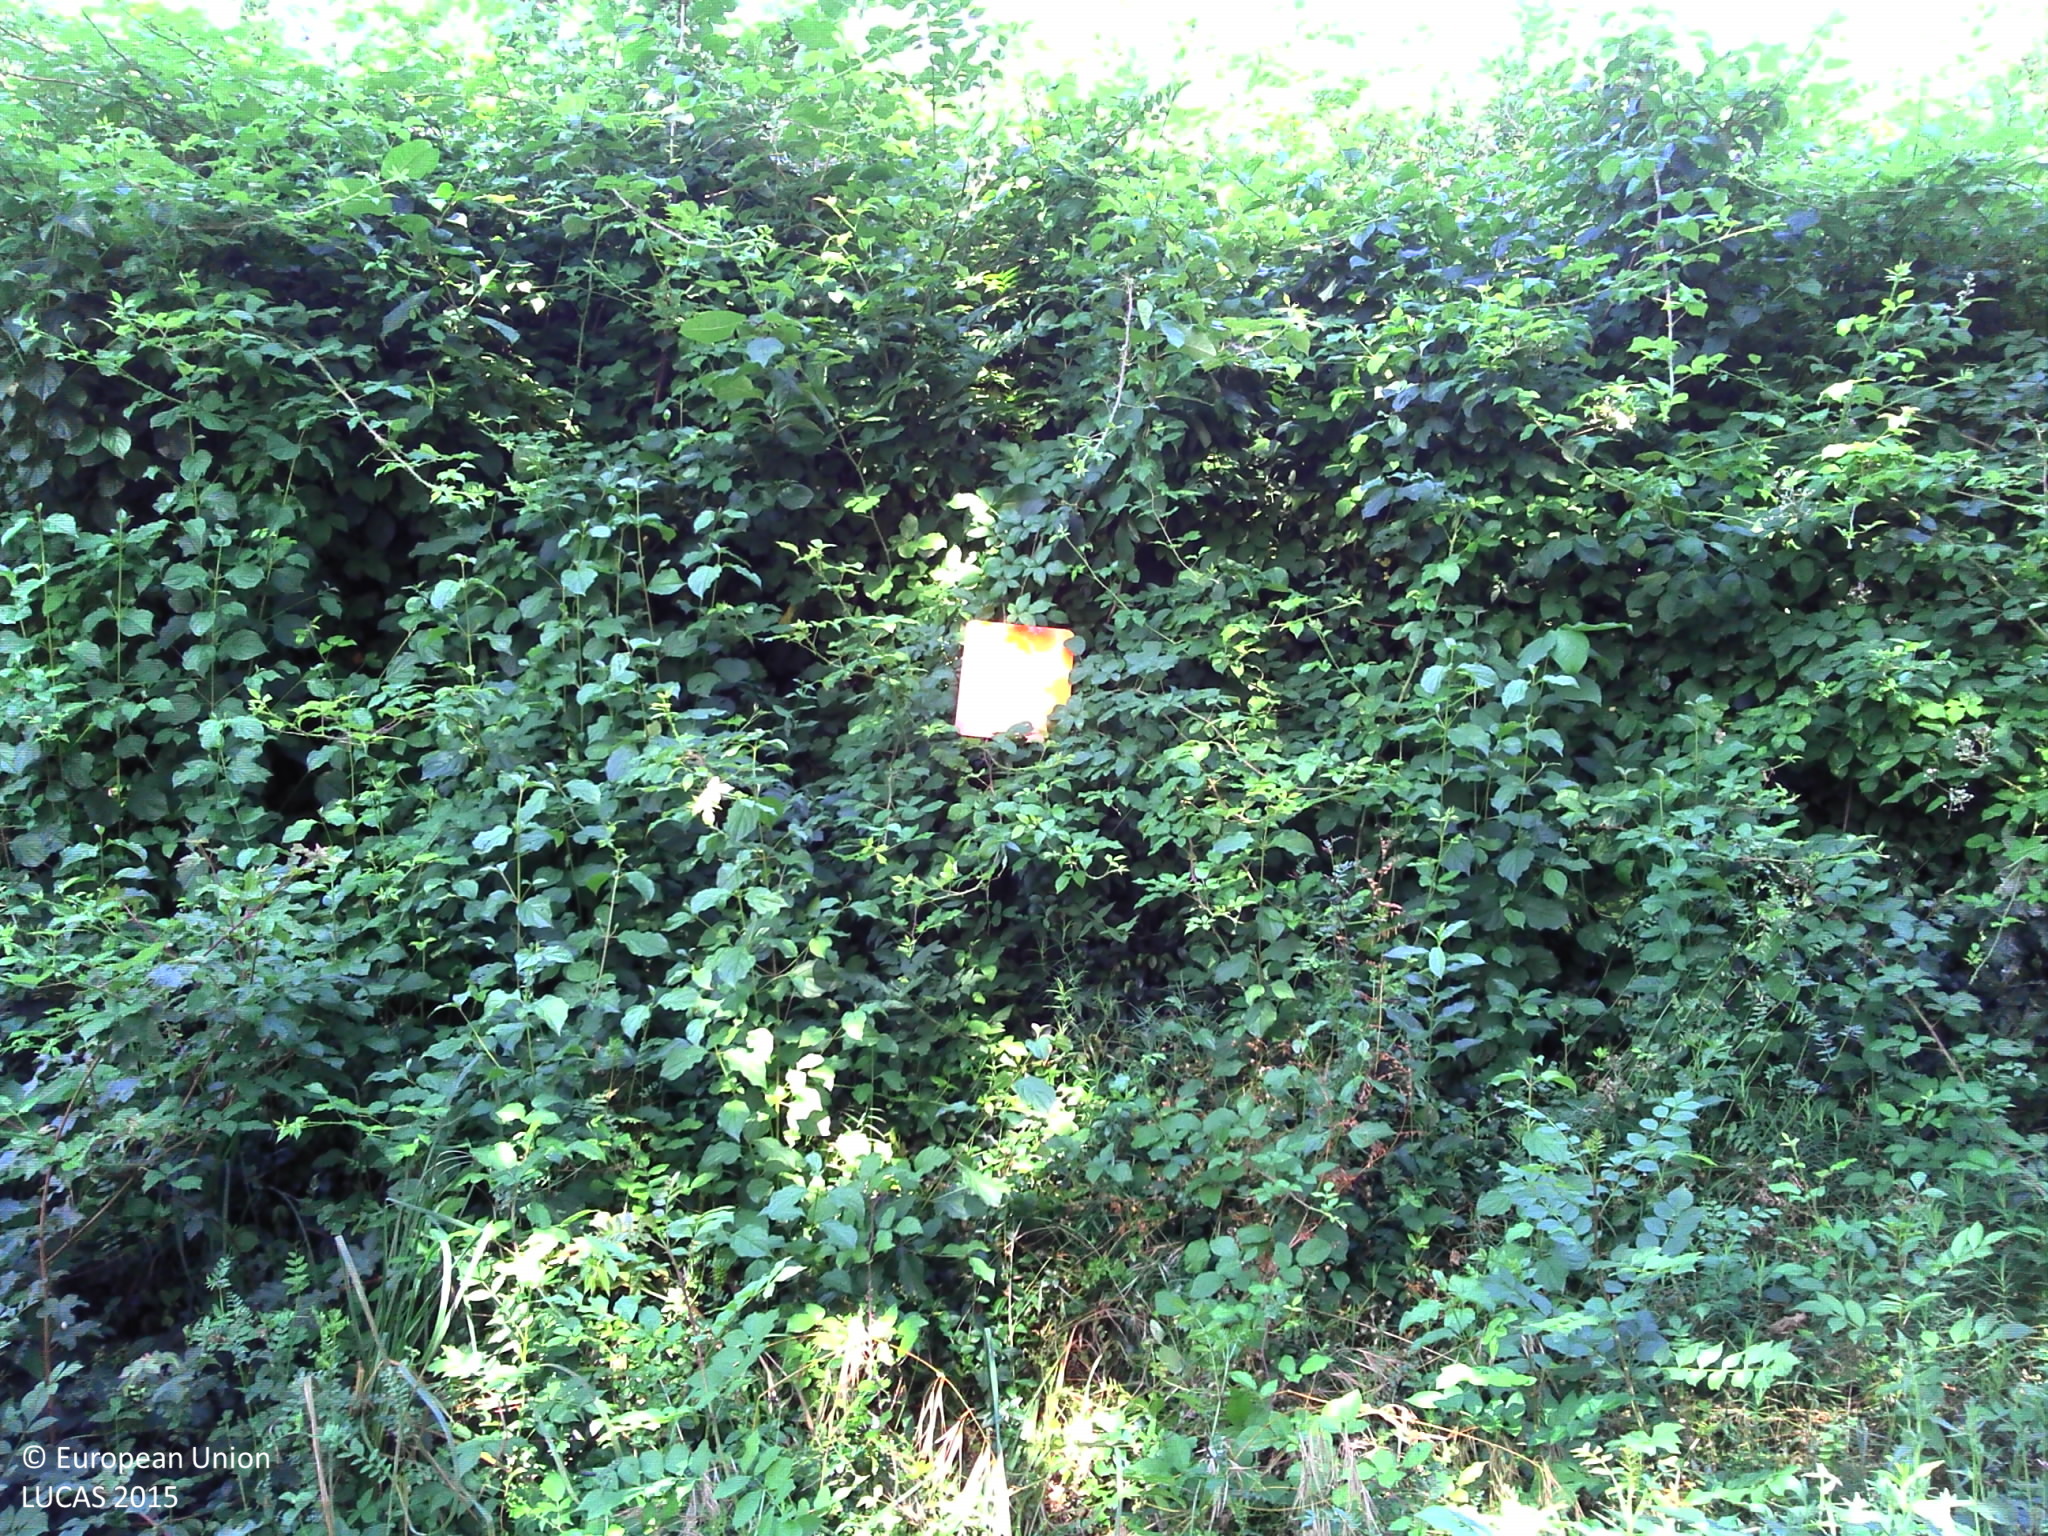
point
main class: Woodland
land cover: Broadleaved woodland
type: thermophilous deciduous forest
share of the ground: > 75 %
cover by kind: broadleaved forest trees 65 %, shrubs 30 %, herbaceous plants 5 %
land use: Forestry
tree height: > 5 m
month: June
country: FR
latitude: 45.6846
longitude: 0.4200
